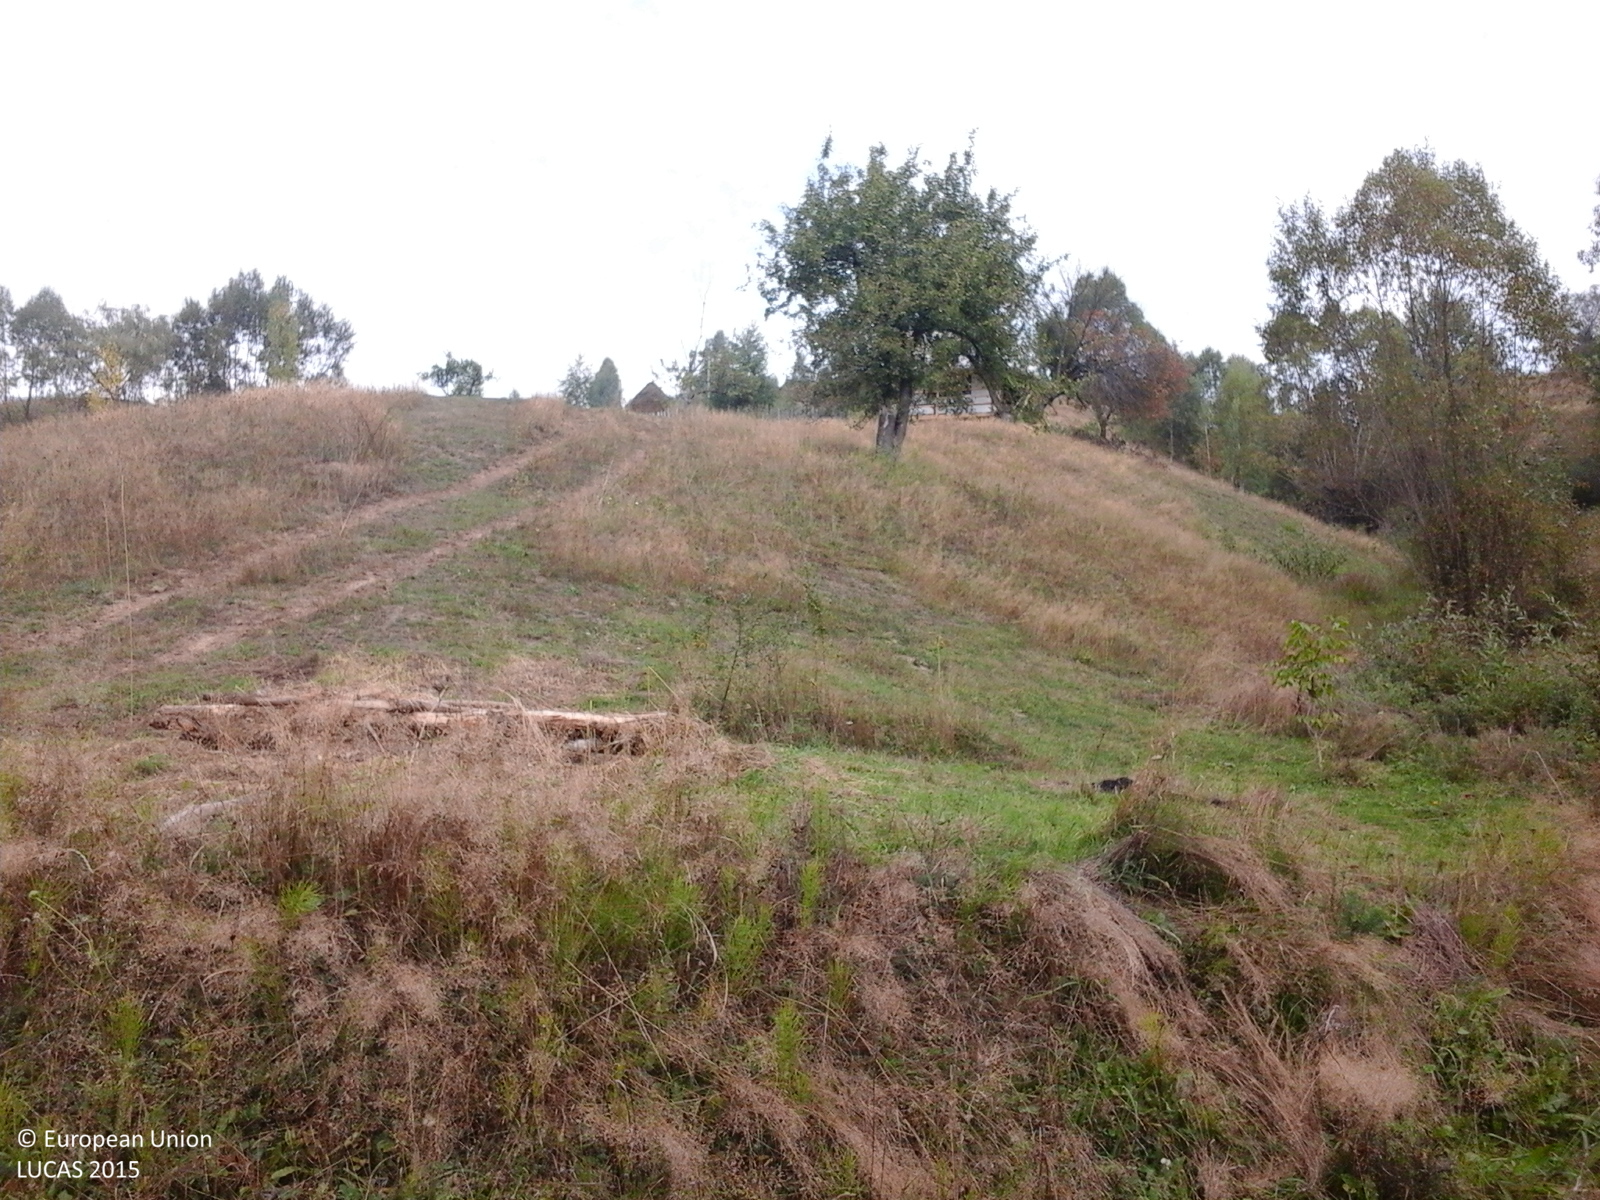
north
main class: Grassland
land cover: Grassland without tree/shrub cover
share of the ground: > 75 %
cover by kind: herbaceous plants 100 %
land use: Agriculture (excluding fallow land and kitchen gardens)
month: September
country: RO
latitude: 45.4606
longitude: 23.4497
